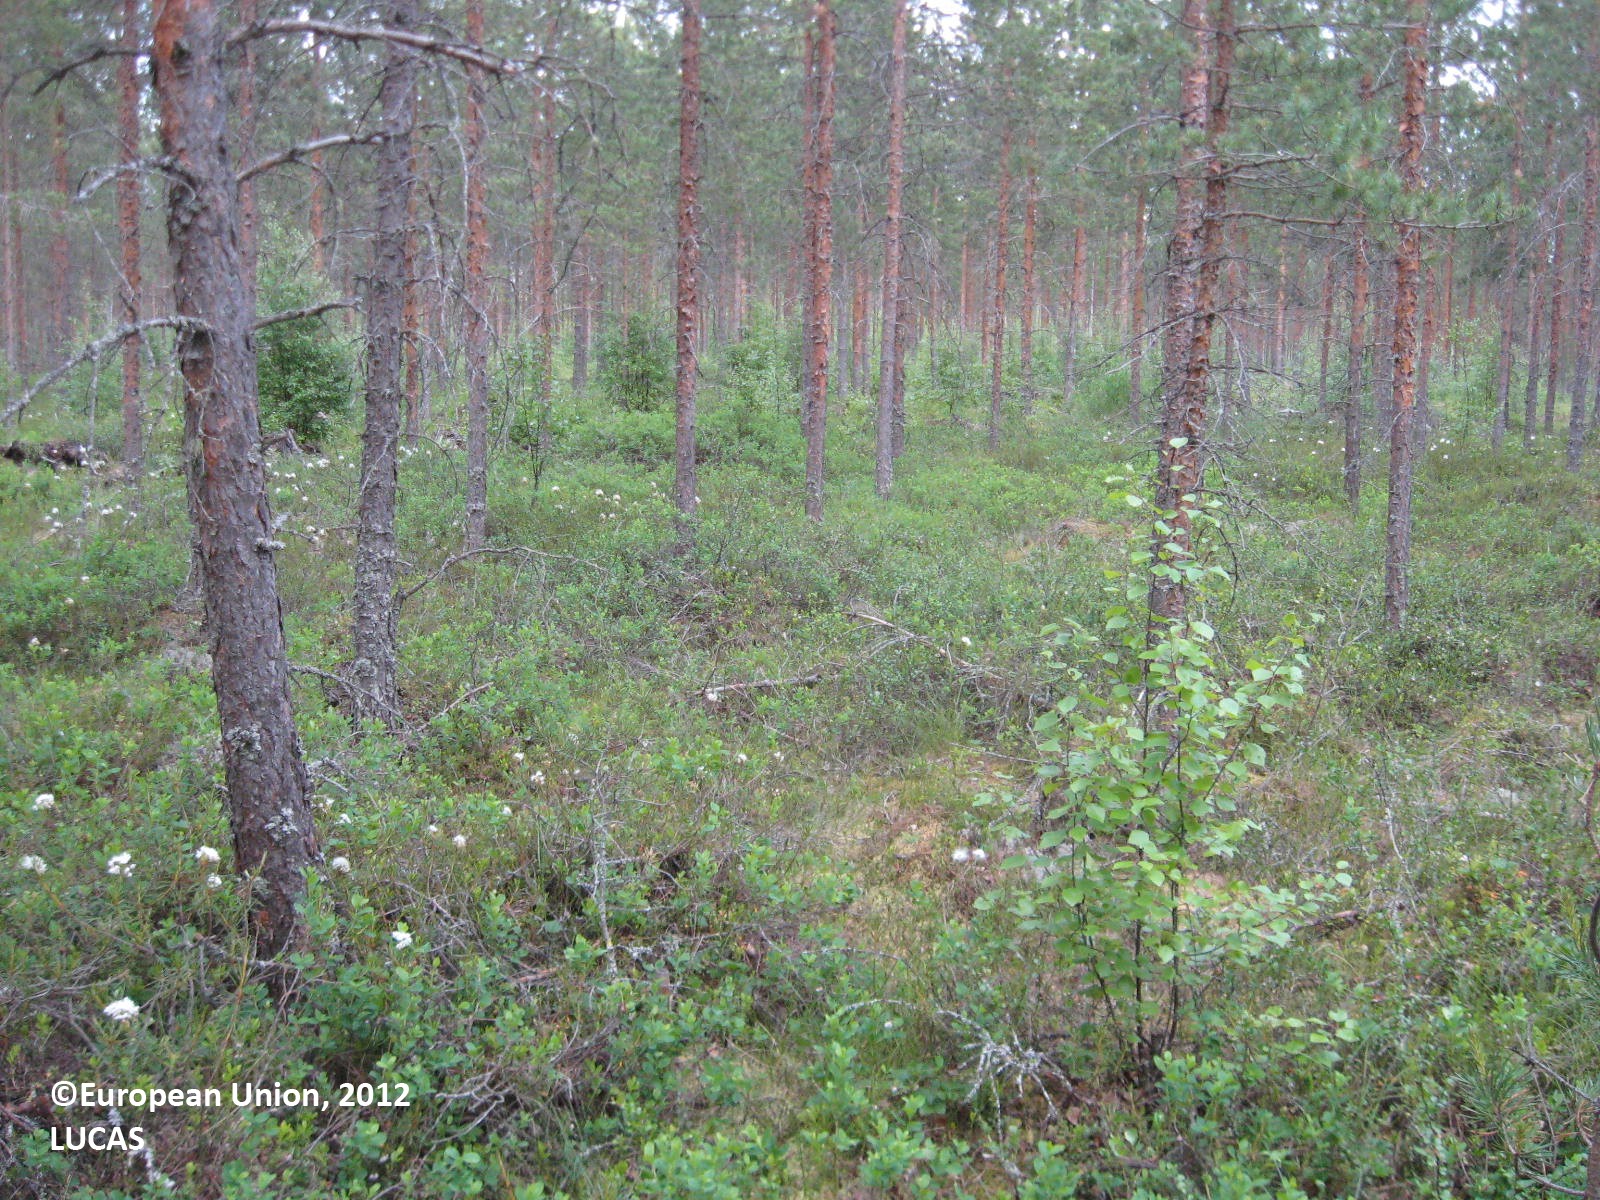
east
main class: Woodland
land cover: Pine dominated coniferous woodland
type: boreal forest
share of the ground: > 75 %
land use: Forestry
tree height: > 5 m
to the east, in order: Pine dominated coniferous woodland; Ditches and canals; Pine dominated coniferous woodland; Other mixed woodland; Broadleaved woodland
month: June
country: FI
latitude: 63.0081
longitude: 22.6736
